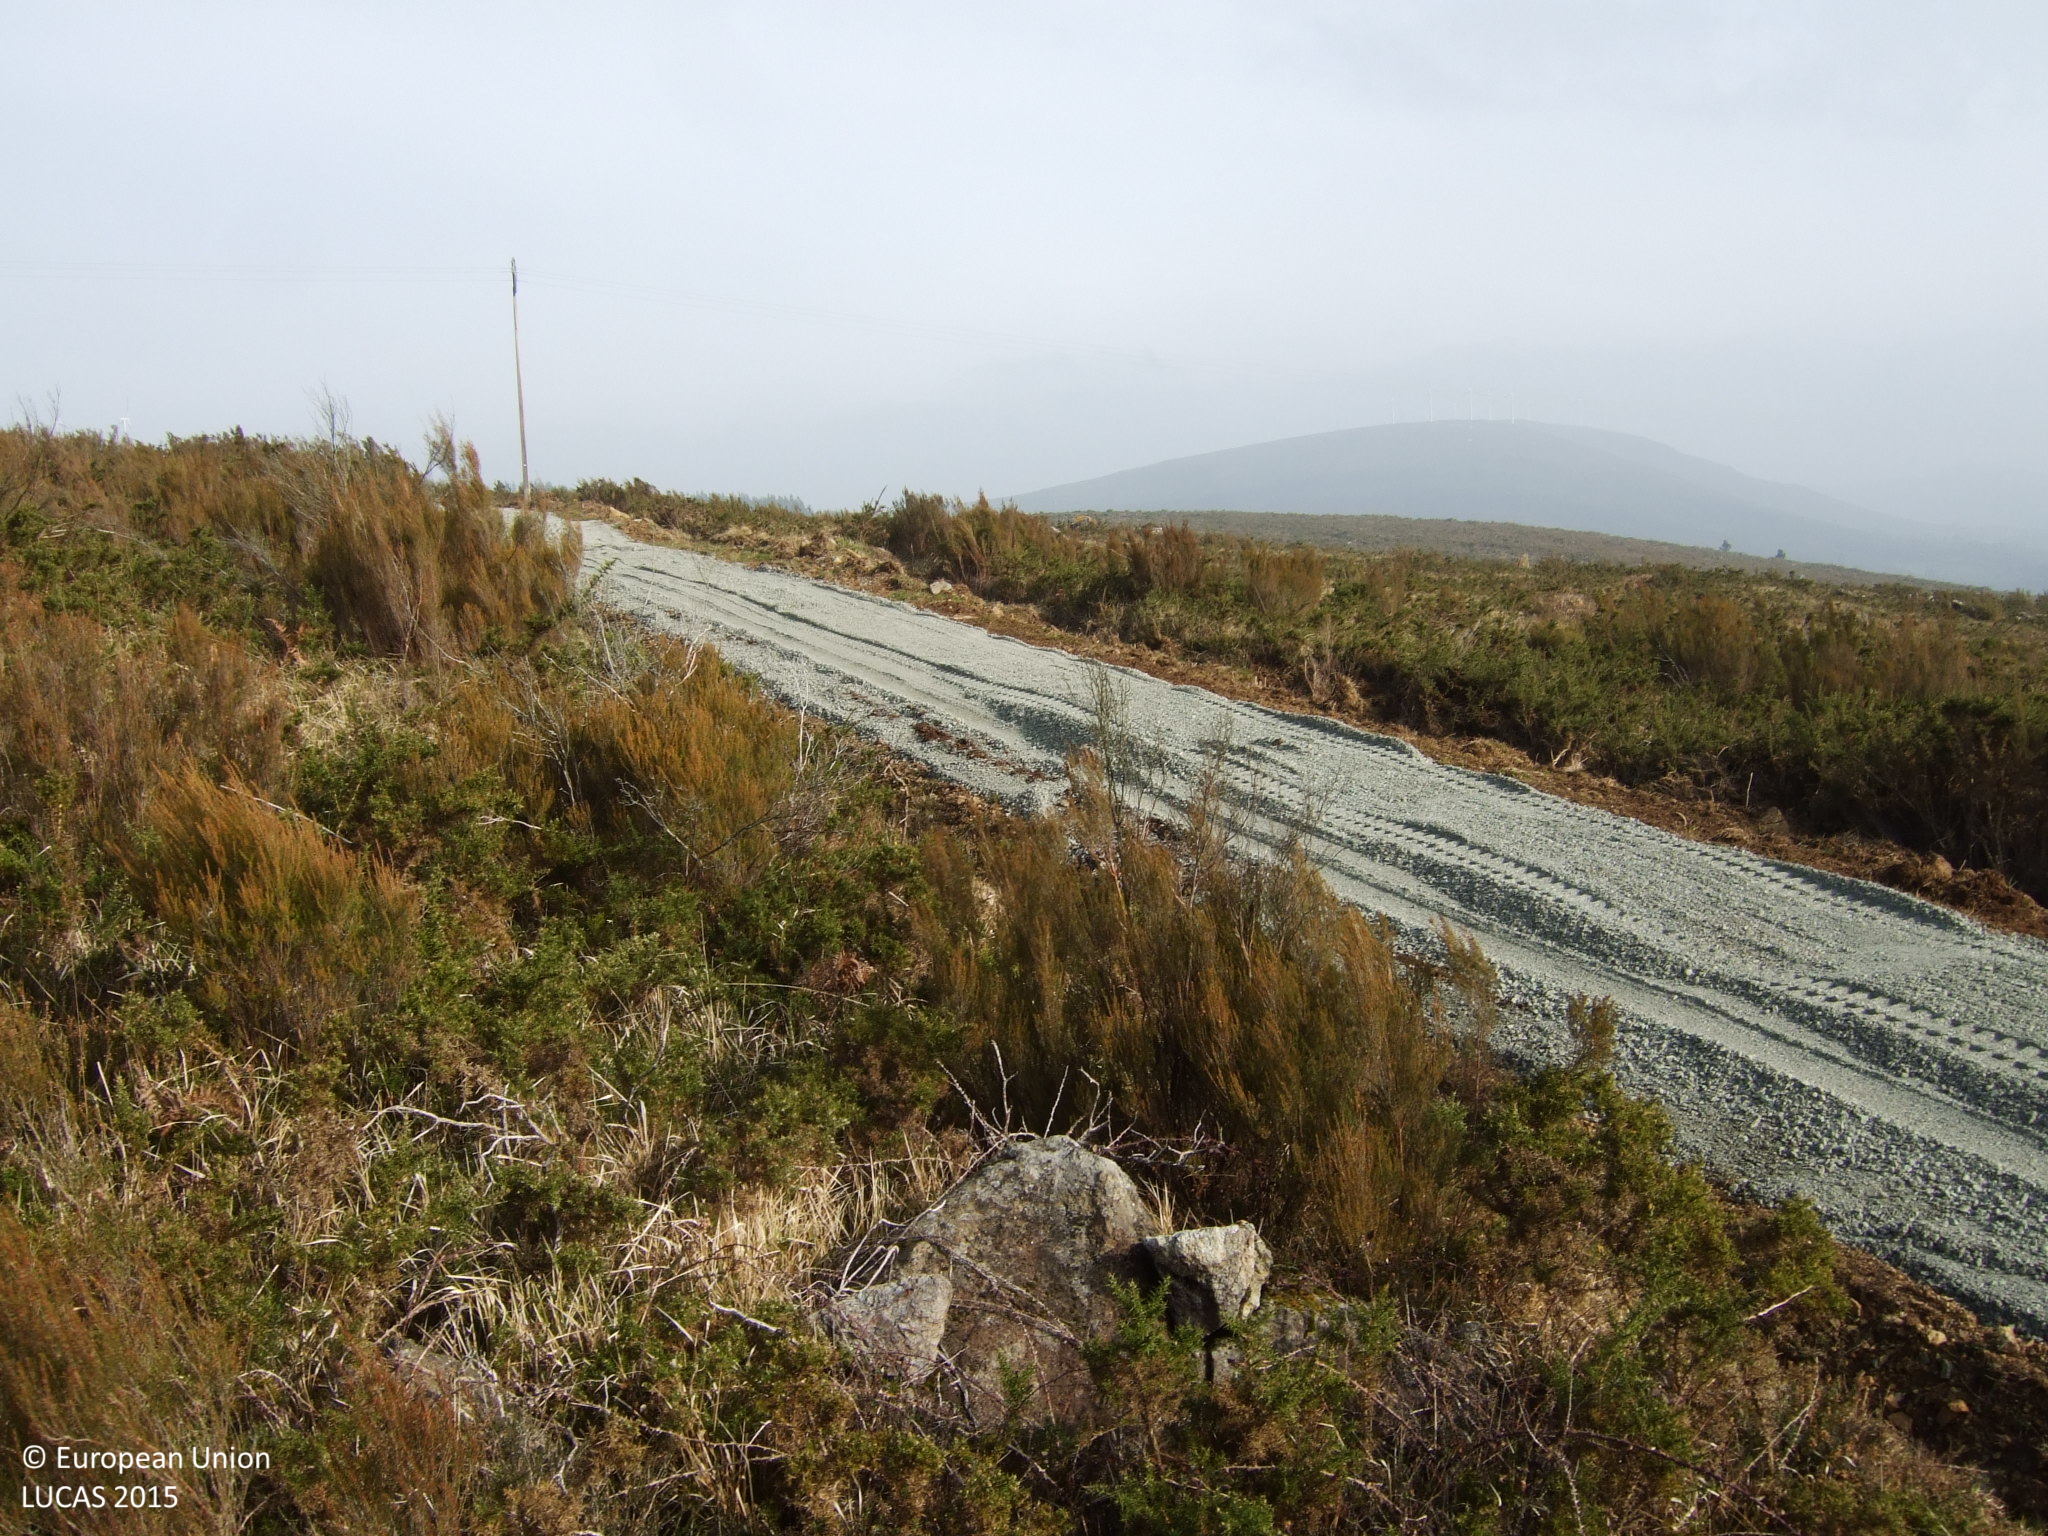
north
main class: Shrubland
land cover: Shrubland without tree cover
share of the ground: > 75 %
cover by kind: shrubs 100 %
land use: Semi-natural and natural areas not in use
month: March
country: ES
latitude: 42.9020
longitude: -7.9308
